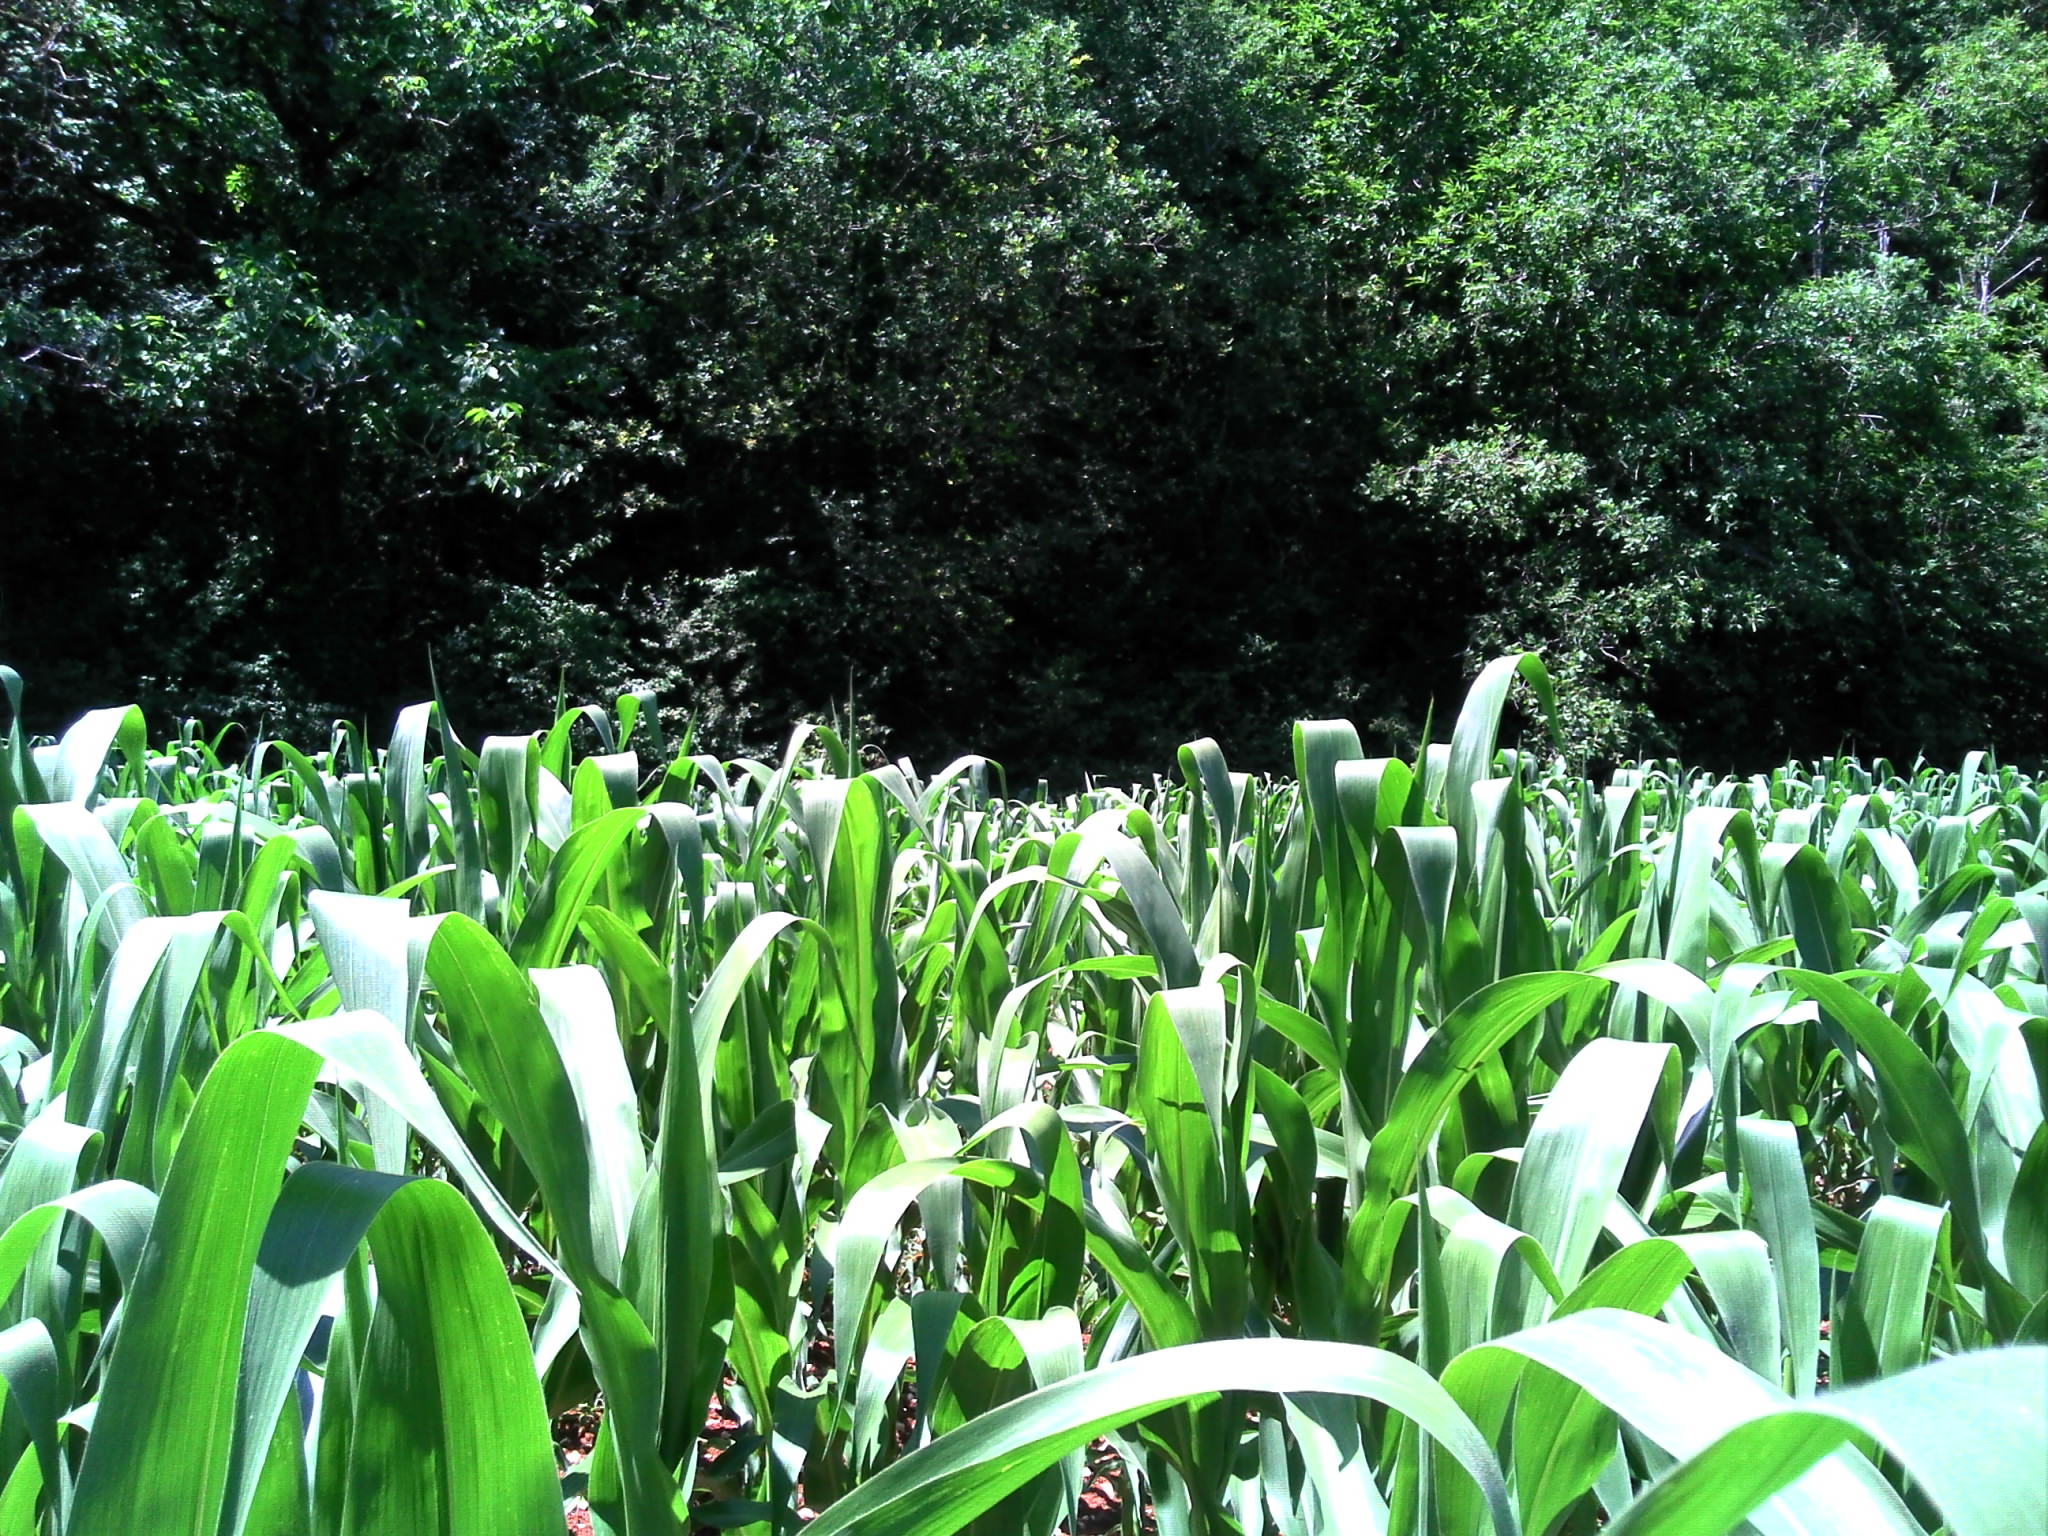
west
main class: Cropland
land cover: Maize
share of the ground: > 75 %
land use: Agriculture (excluding fallow land and kitchen gardens)
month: June
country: FR
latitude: 44.9293
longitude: 1.5453
